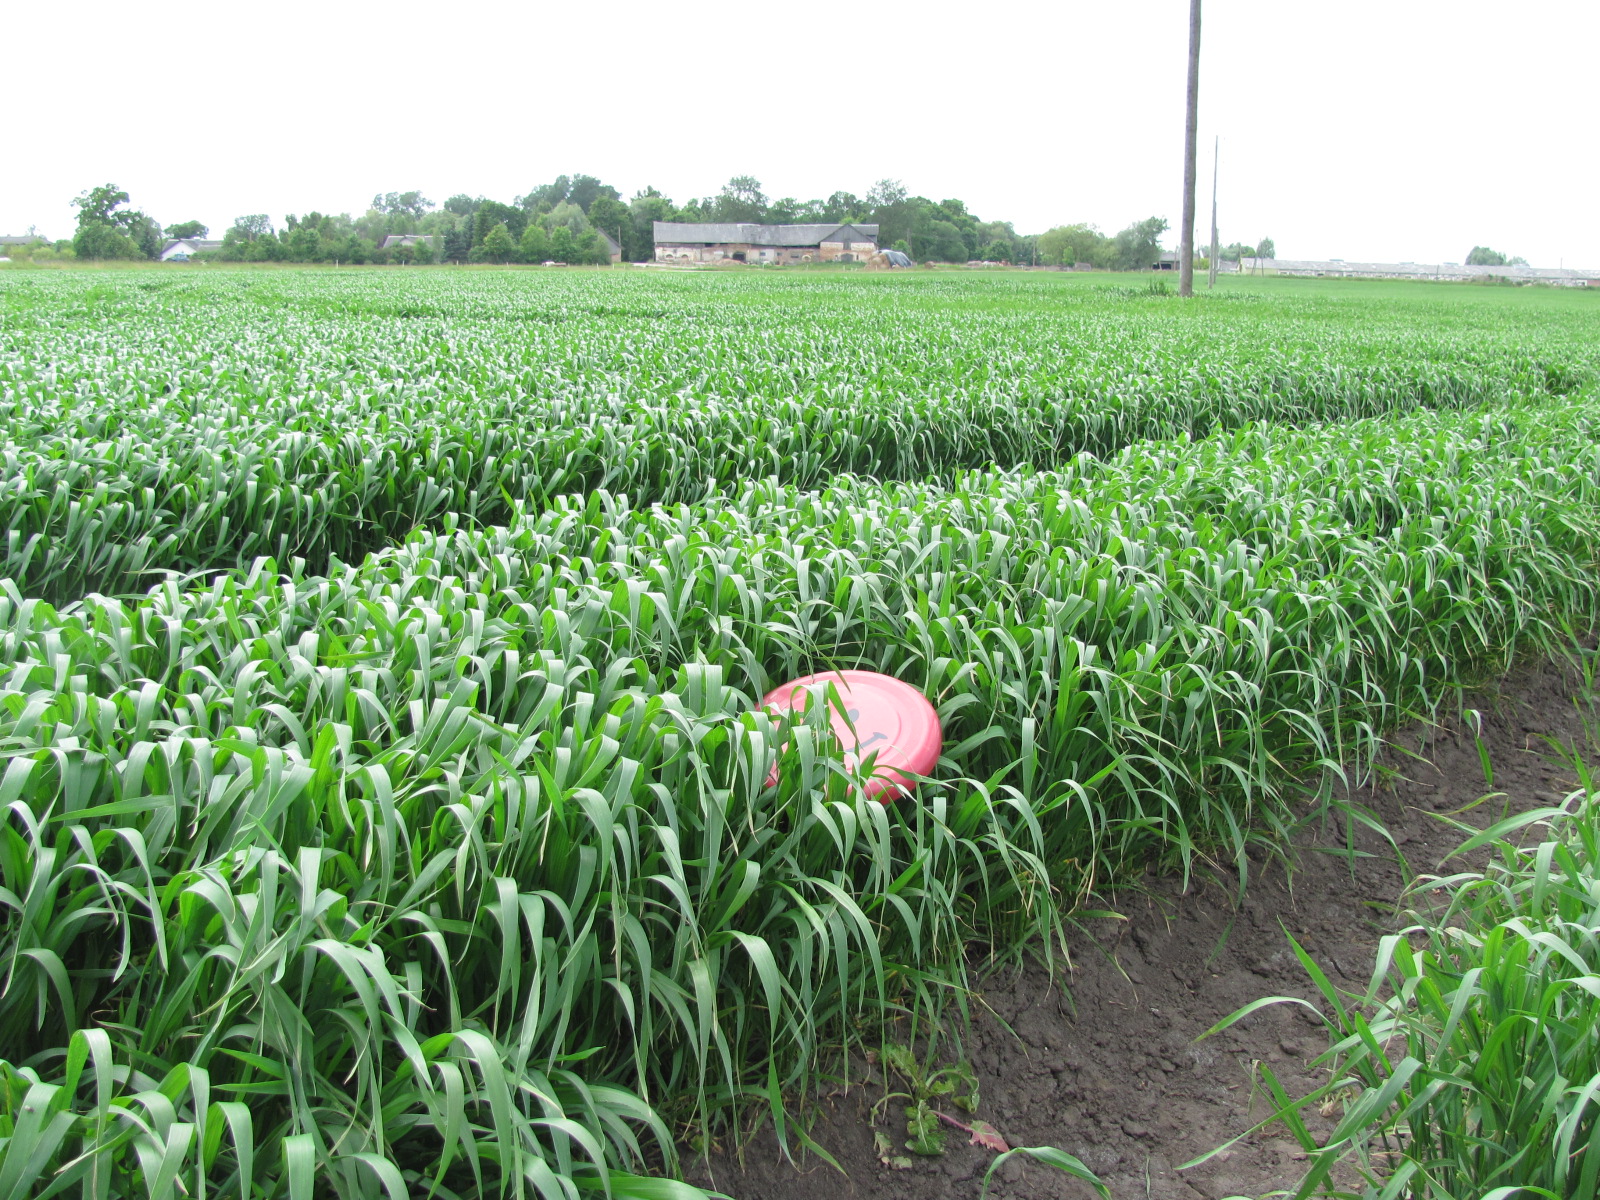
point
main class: Cropland
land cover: Common wheat
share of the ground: > 75 %
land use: Agriculture (excluding fallow land and kitchen gardens)
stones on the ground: < 10 %
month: June
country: LV
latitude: 56.2894
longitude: 24.1942
